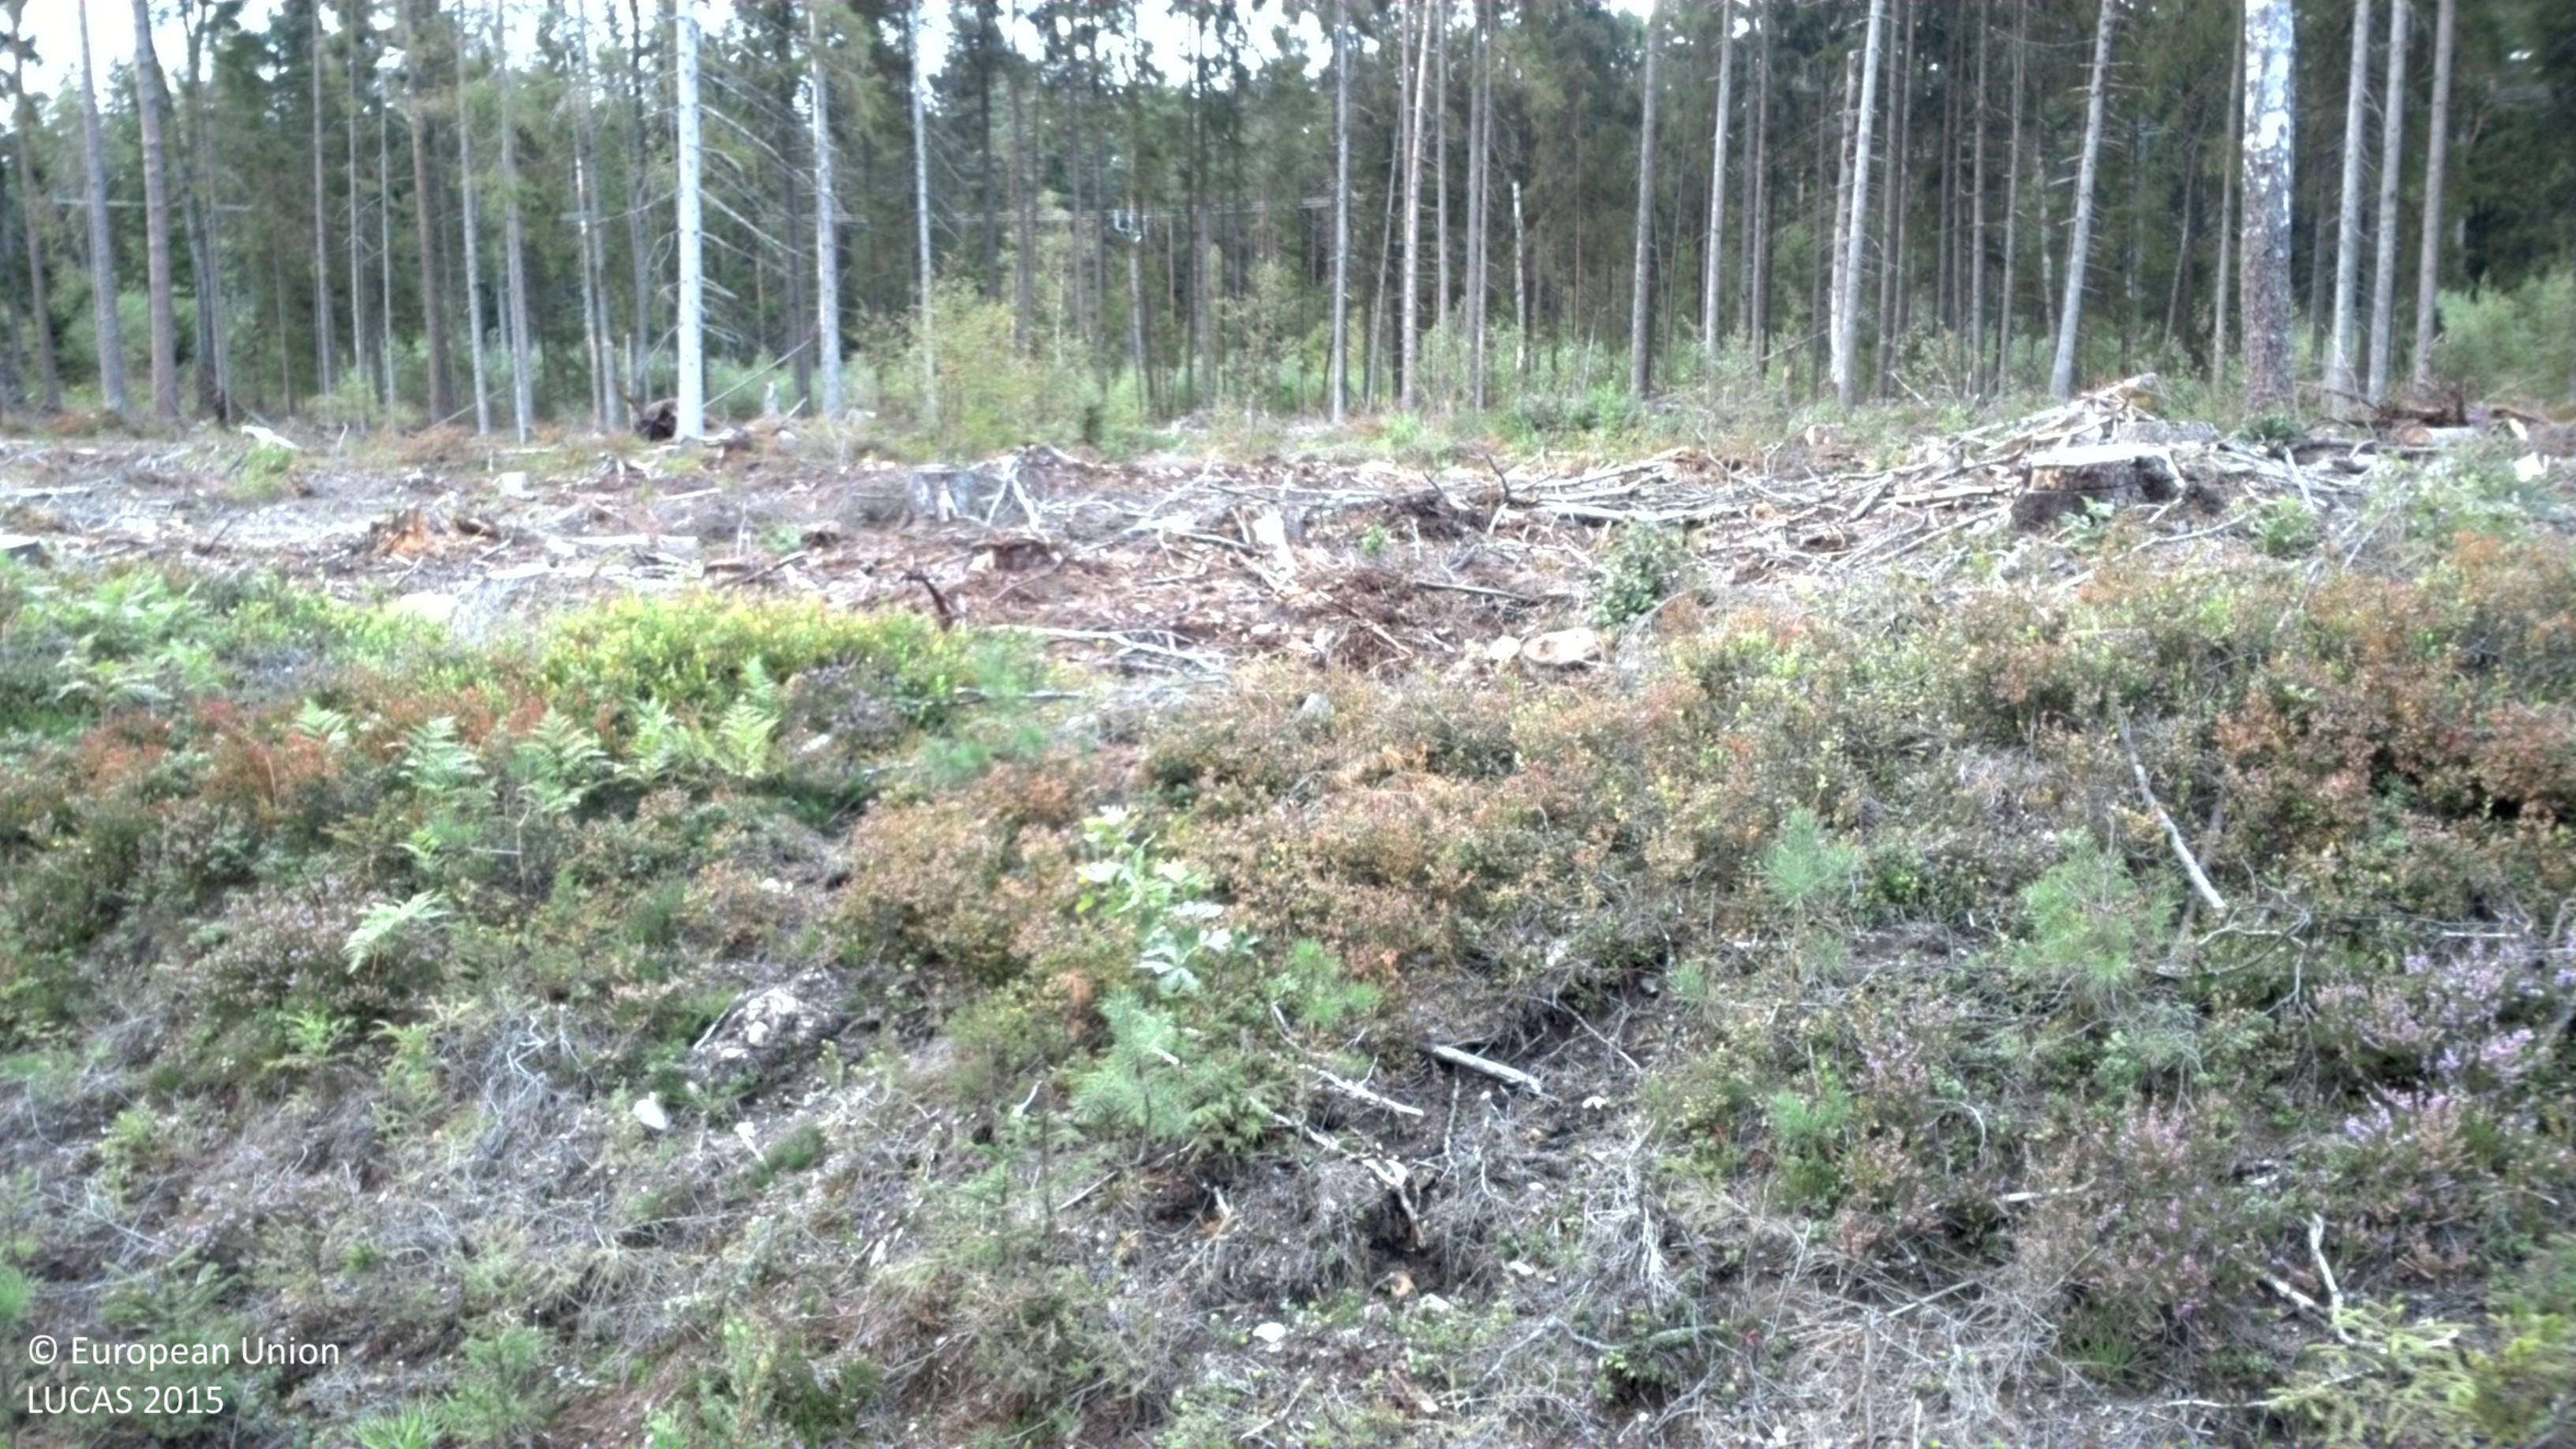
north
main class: Shrubland
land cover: Shrubland with sparse tree cover
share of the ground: > 75 %
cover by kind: shrubs 90 %, coniferous forest trees 5 %
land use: Forestry
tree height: < 5 m
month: August
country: SE
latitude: 56.3639
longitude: 14.4168
